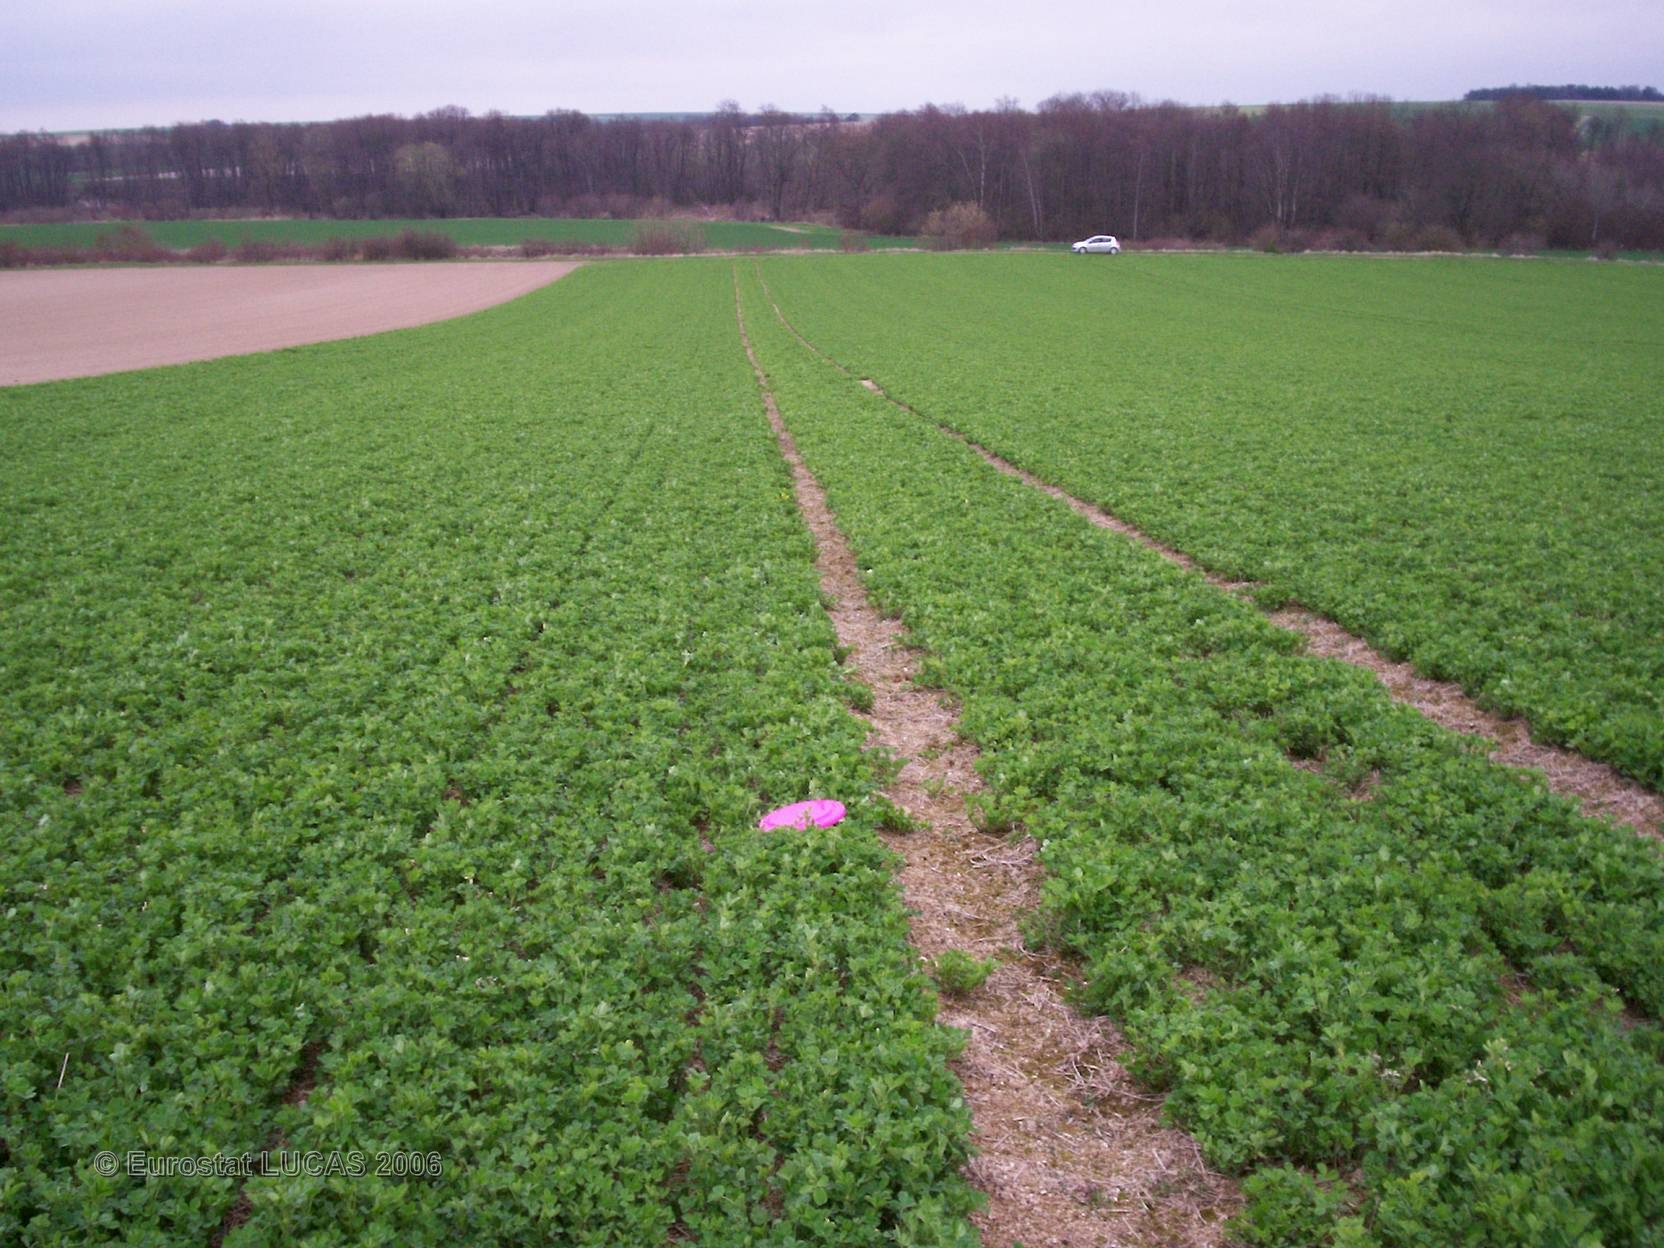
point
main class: Cropland
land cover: Lucerne
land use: Agriculture (excluding fallow land and kitchen gardens)
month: April
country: FR
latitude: 49.2371
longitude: 4.4339
